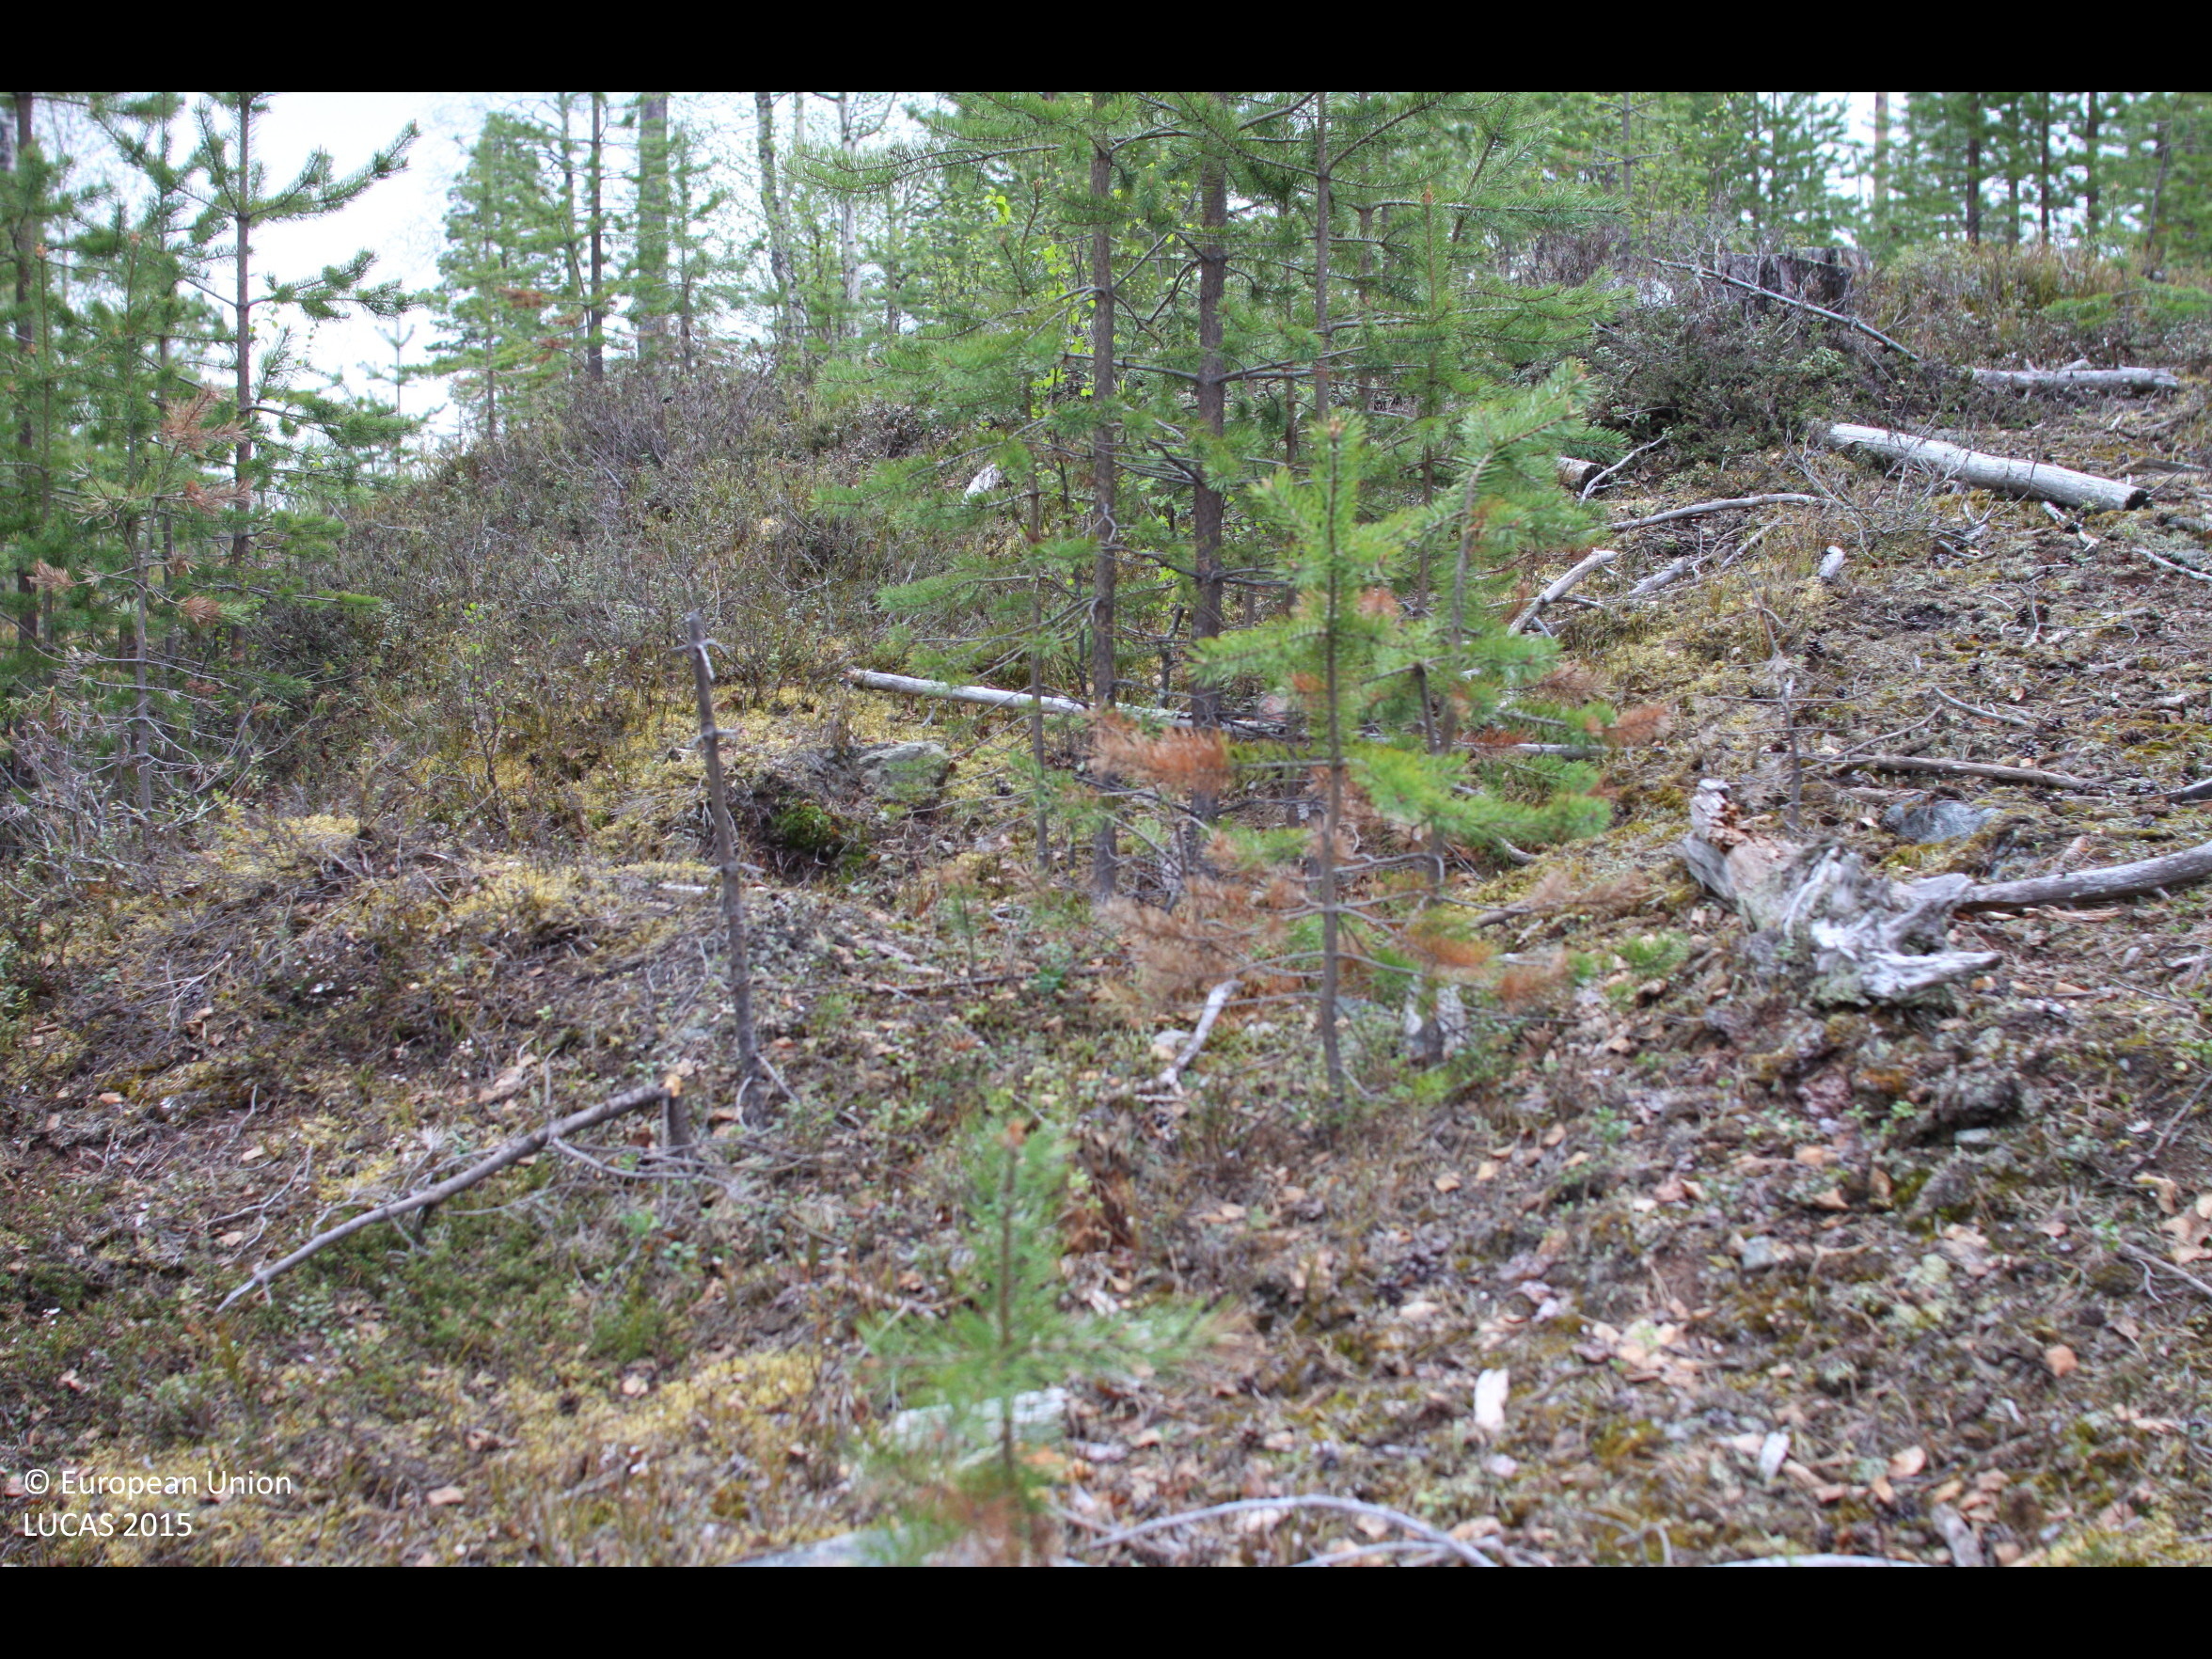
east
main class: Woodland
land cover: Pine dominated coniferous woodland
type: boreal forest
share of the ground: 50 - 75 %
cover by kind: coniferous forest trees 45 %, shrubs 45 %, broadleaved forest trees 10 %
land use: Forestry
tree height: > 5 m
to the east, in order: Pine dominated coniferous woodland; Pine dominated mixed woodland; Pine dominated coniferous woodland; Electric lines; Pine dominated coniferous woodland
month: May
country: FI
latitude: 66.1224
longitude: 28.4598
